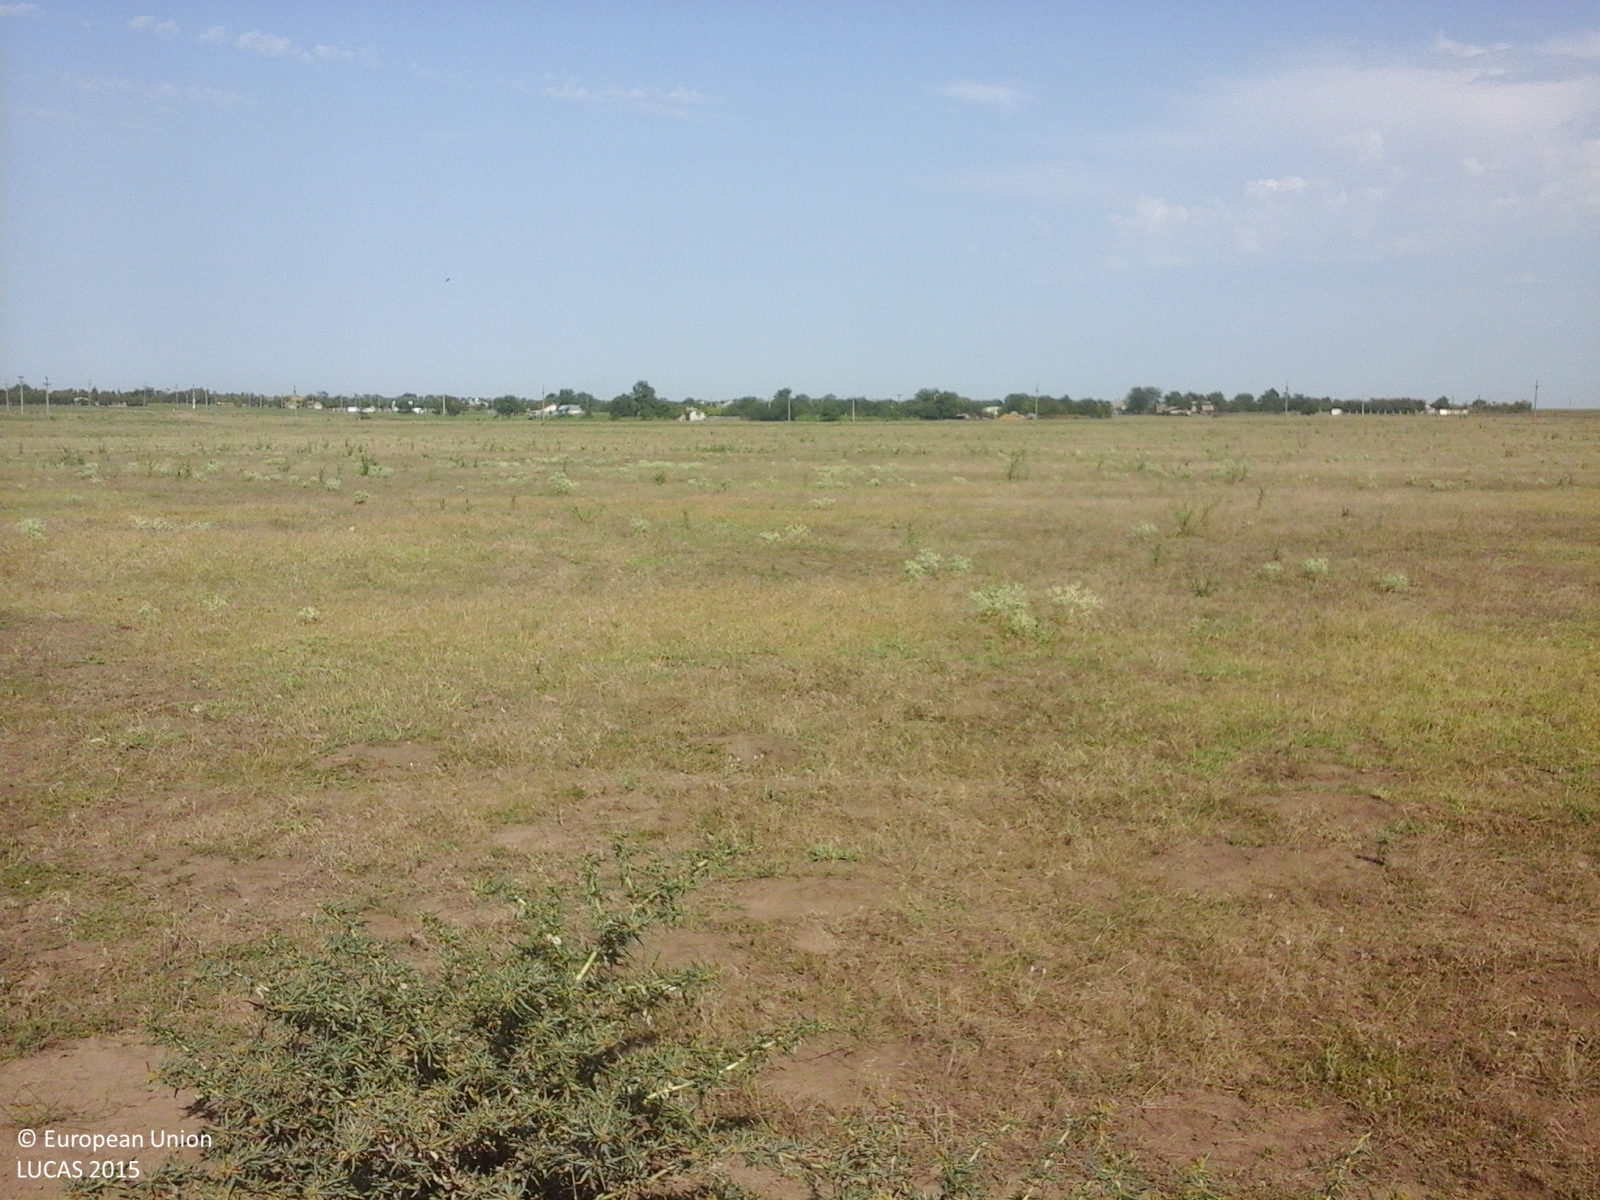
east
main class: Grassland
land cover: Grassland without tree/shrub cover
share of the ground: > 75 %
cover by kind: herbaceous plants 100 %
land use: Agriculture (excluding fallow land and kitchen gardens)
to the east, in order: Ditches and canals; Grassland without tree/shrub cover
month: August
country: RO
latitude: 43.8794
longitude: 28.3442
